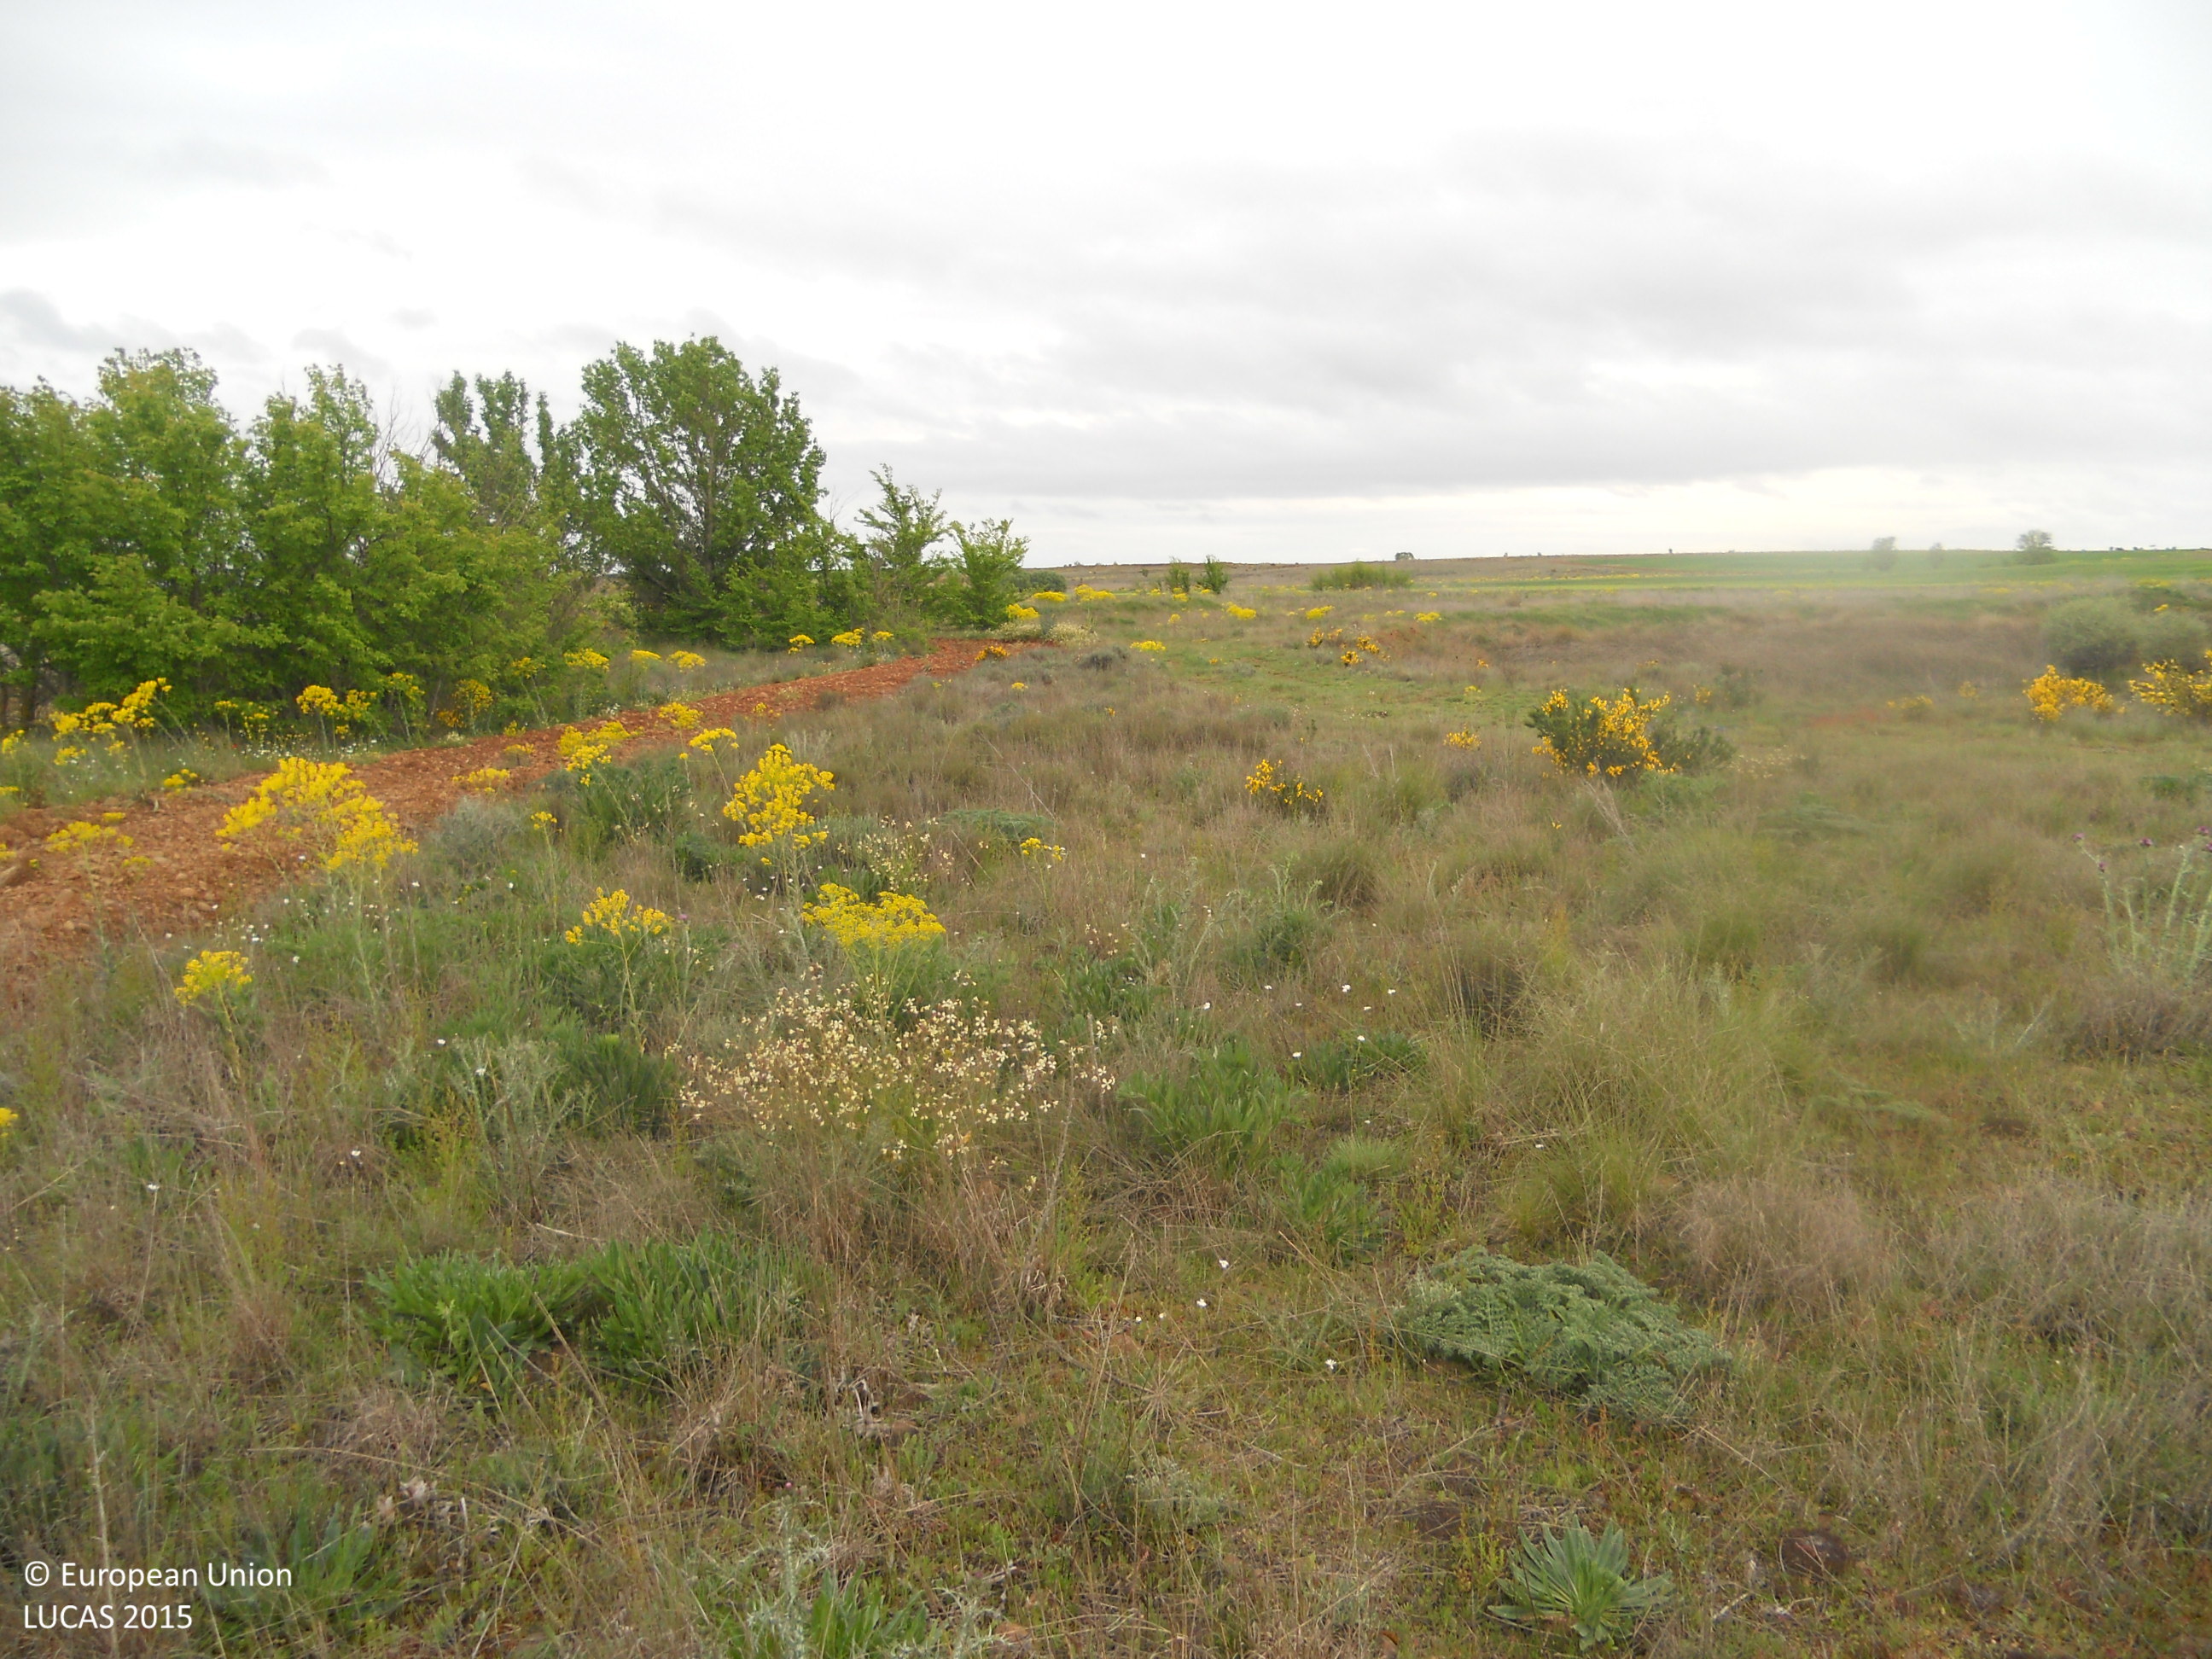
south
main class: Grassland
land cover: Spontaneously vegetated surfaces
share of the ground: > 75 %
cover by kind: herbaceous plants 80 %, unconsolidated bare surface 20 %
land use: Fallow land
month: May
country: ES
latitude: 42.2756
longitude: -5.2802
